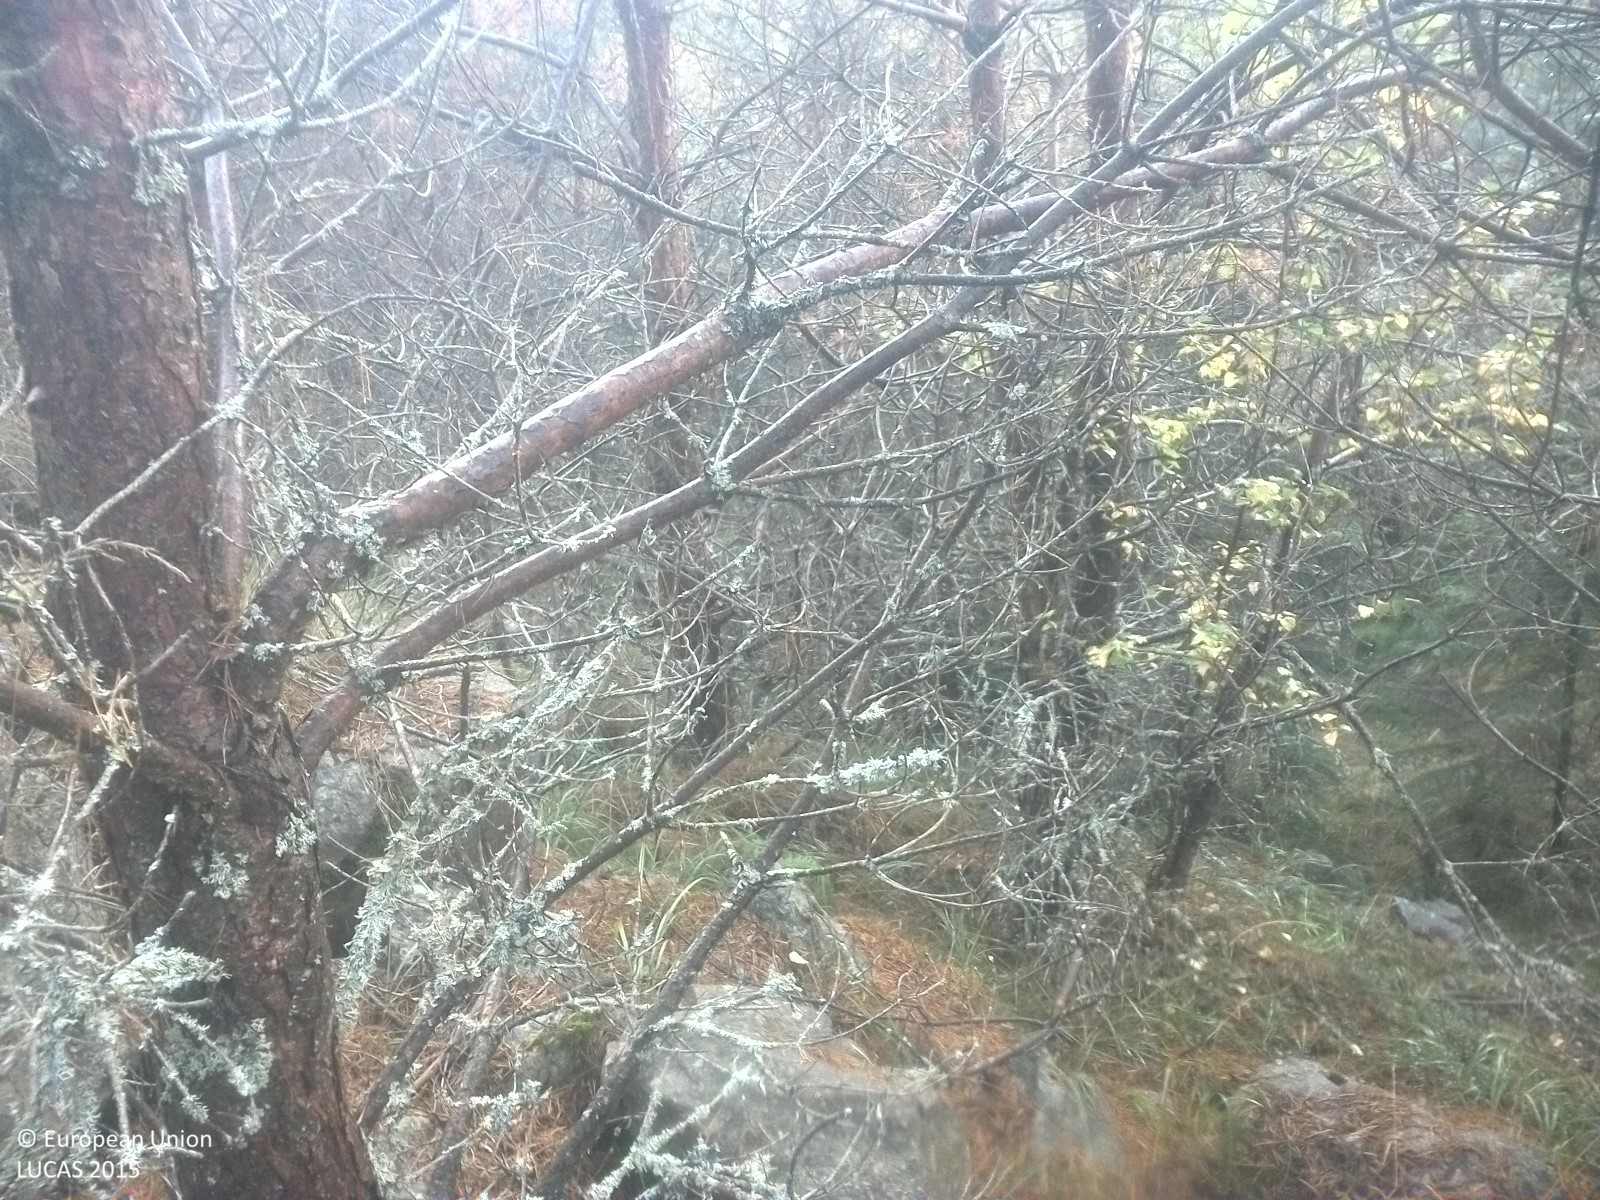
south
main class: Woodland
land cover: Pine dominated coniferous woodland
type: boreal forest
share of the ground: 50 - 75 %
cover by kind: coniferous forest trees 60 %, lichens and mosses 25 %, herbaceous plants 15 %
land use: Forestry
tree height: < 5 m
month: September
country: SE
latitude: 58.7950
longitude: 16.2761
